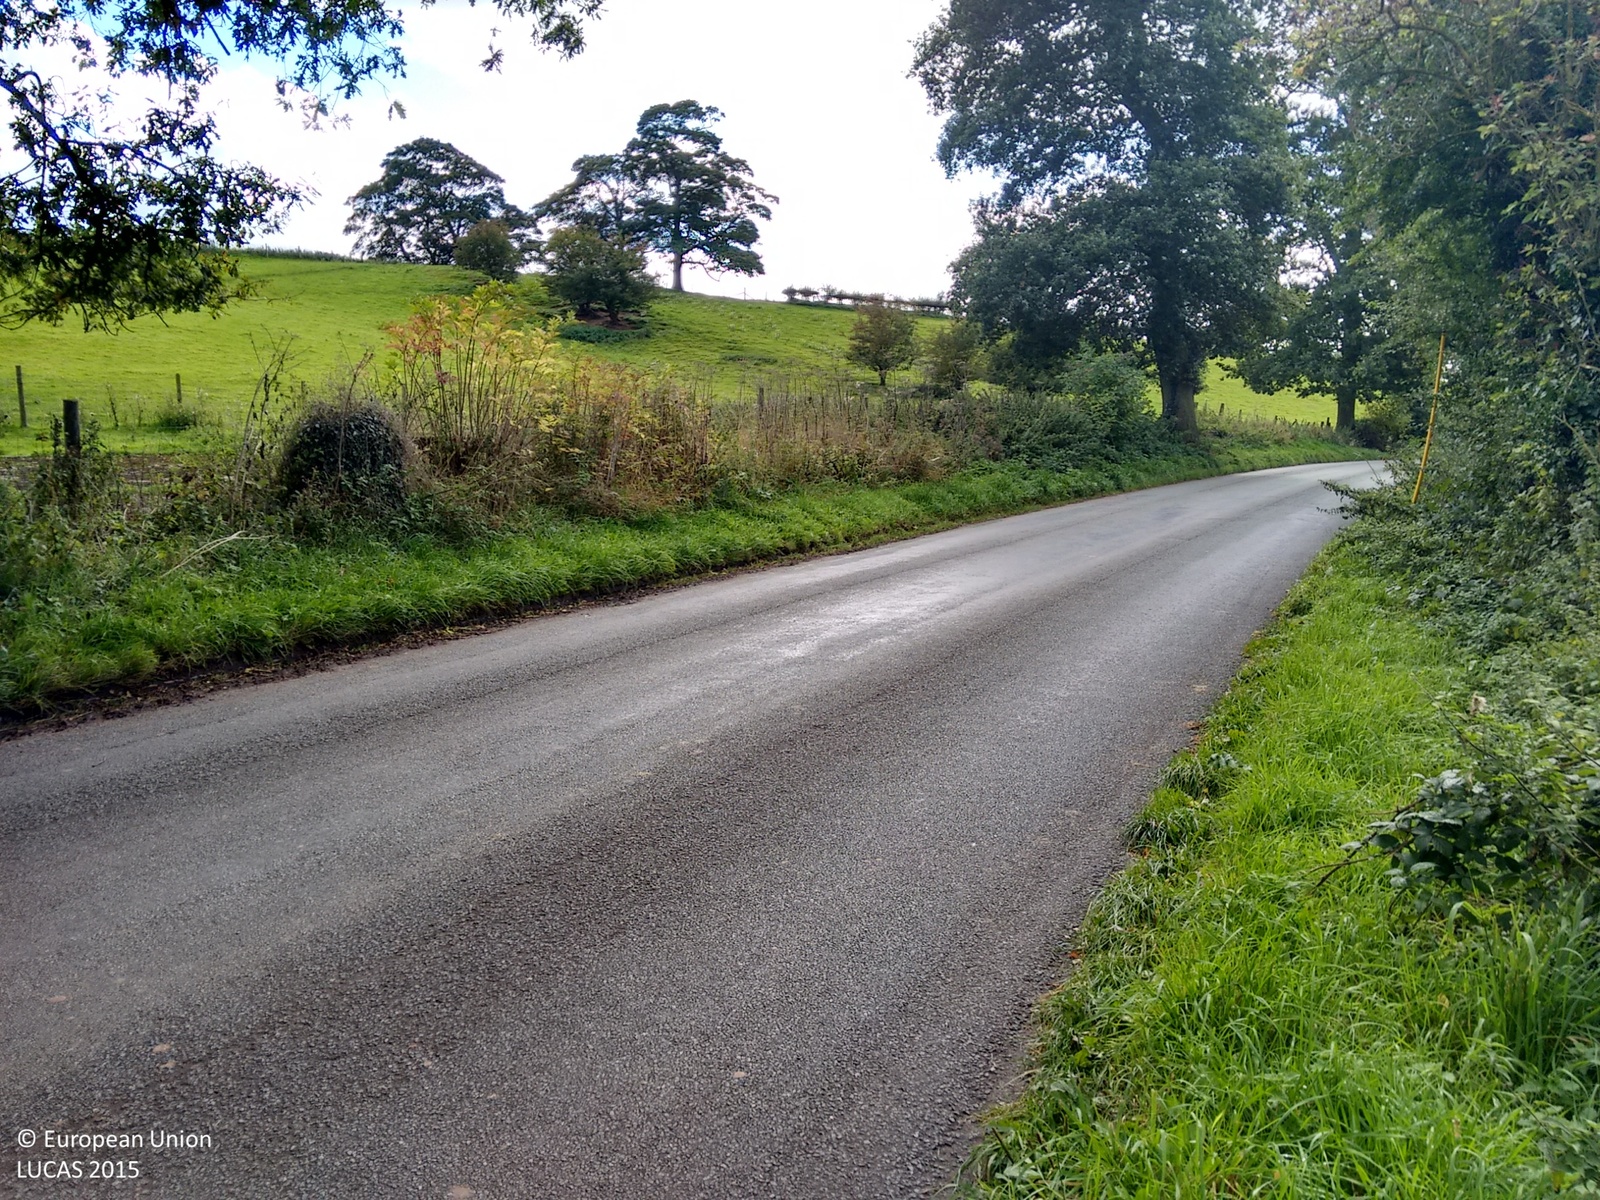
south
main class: Grassland
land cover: Grassland without tree/shrub cover
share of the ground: > 75 %
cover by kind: herbaceous plants 100 %
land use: Agriculture (excluding fallow land and kitchen gardens)
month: September
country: GB
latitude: 52.8675
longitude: -2.0770
